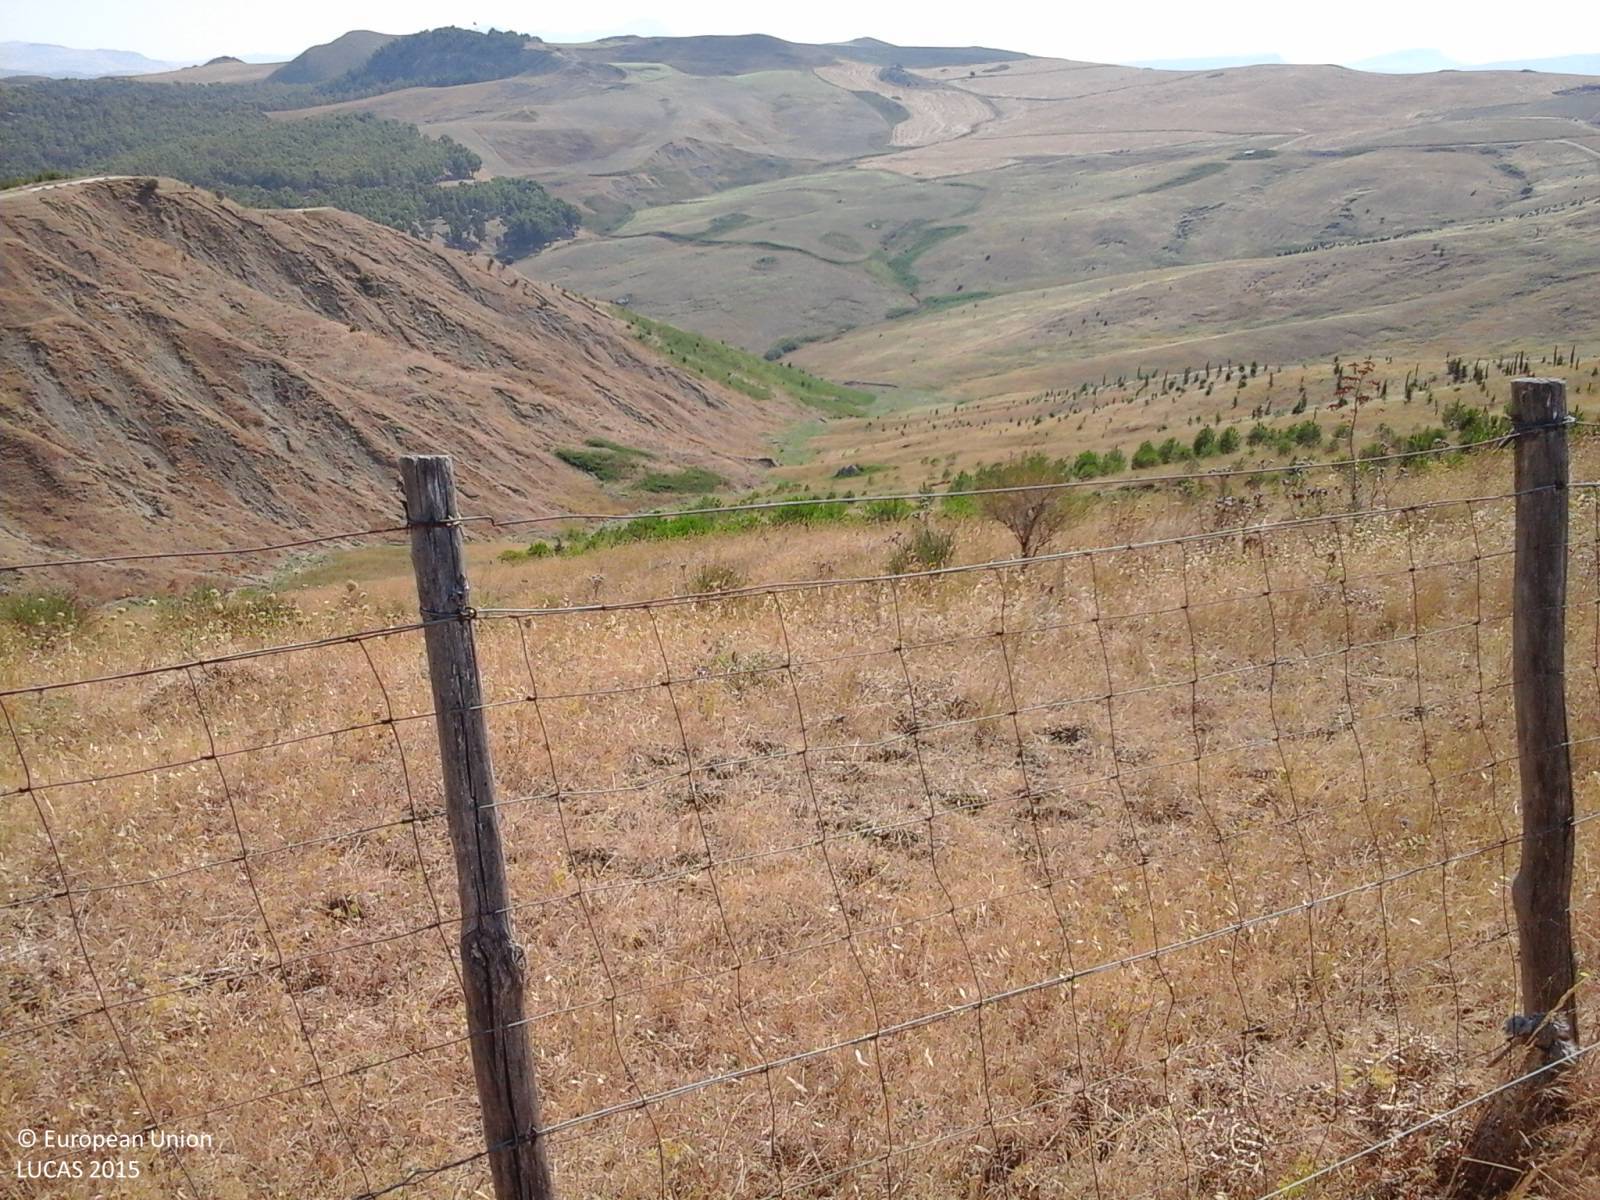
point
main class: Grassland
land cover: Grassland without tree/shrub cover
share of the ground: > 75 %
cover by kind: herbaceous plants 100 %
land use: Semi-natural and natural areas not in use
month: July
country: IT
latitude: 37.7864
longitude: 13.1449
